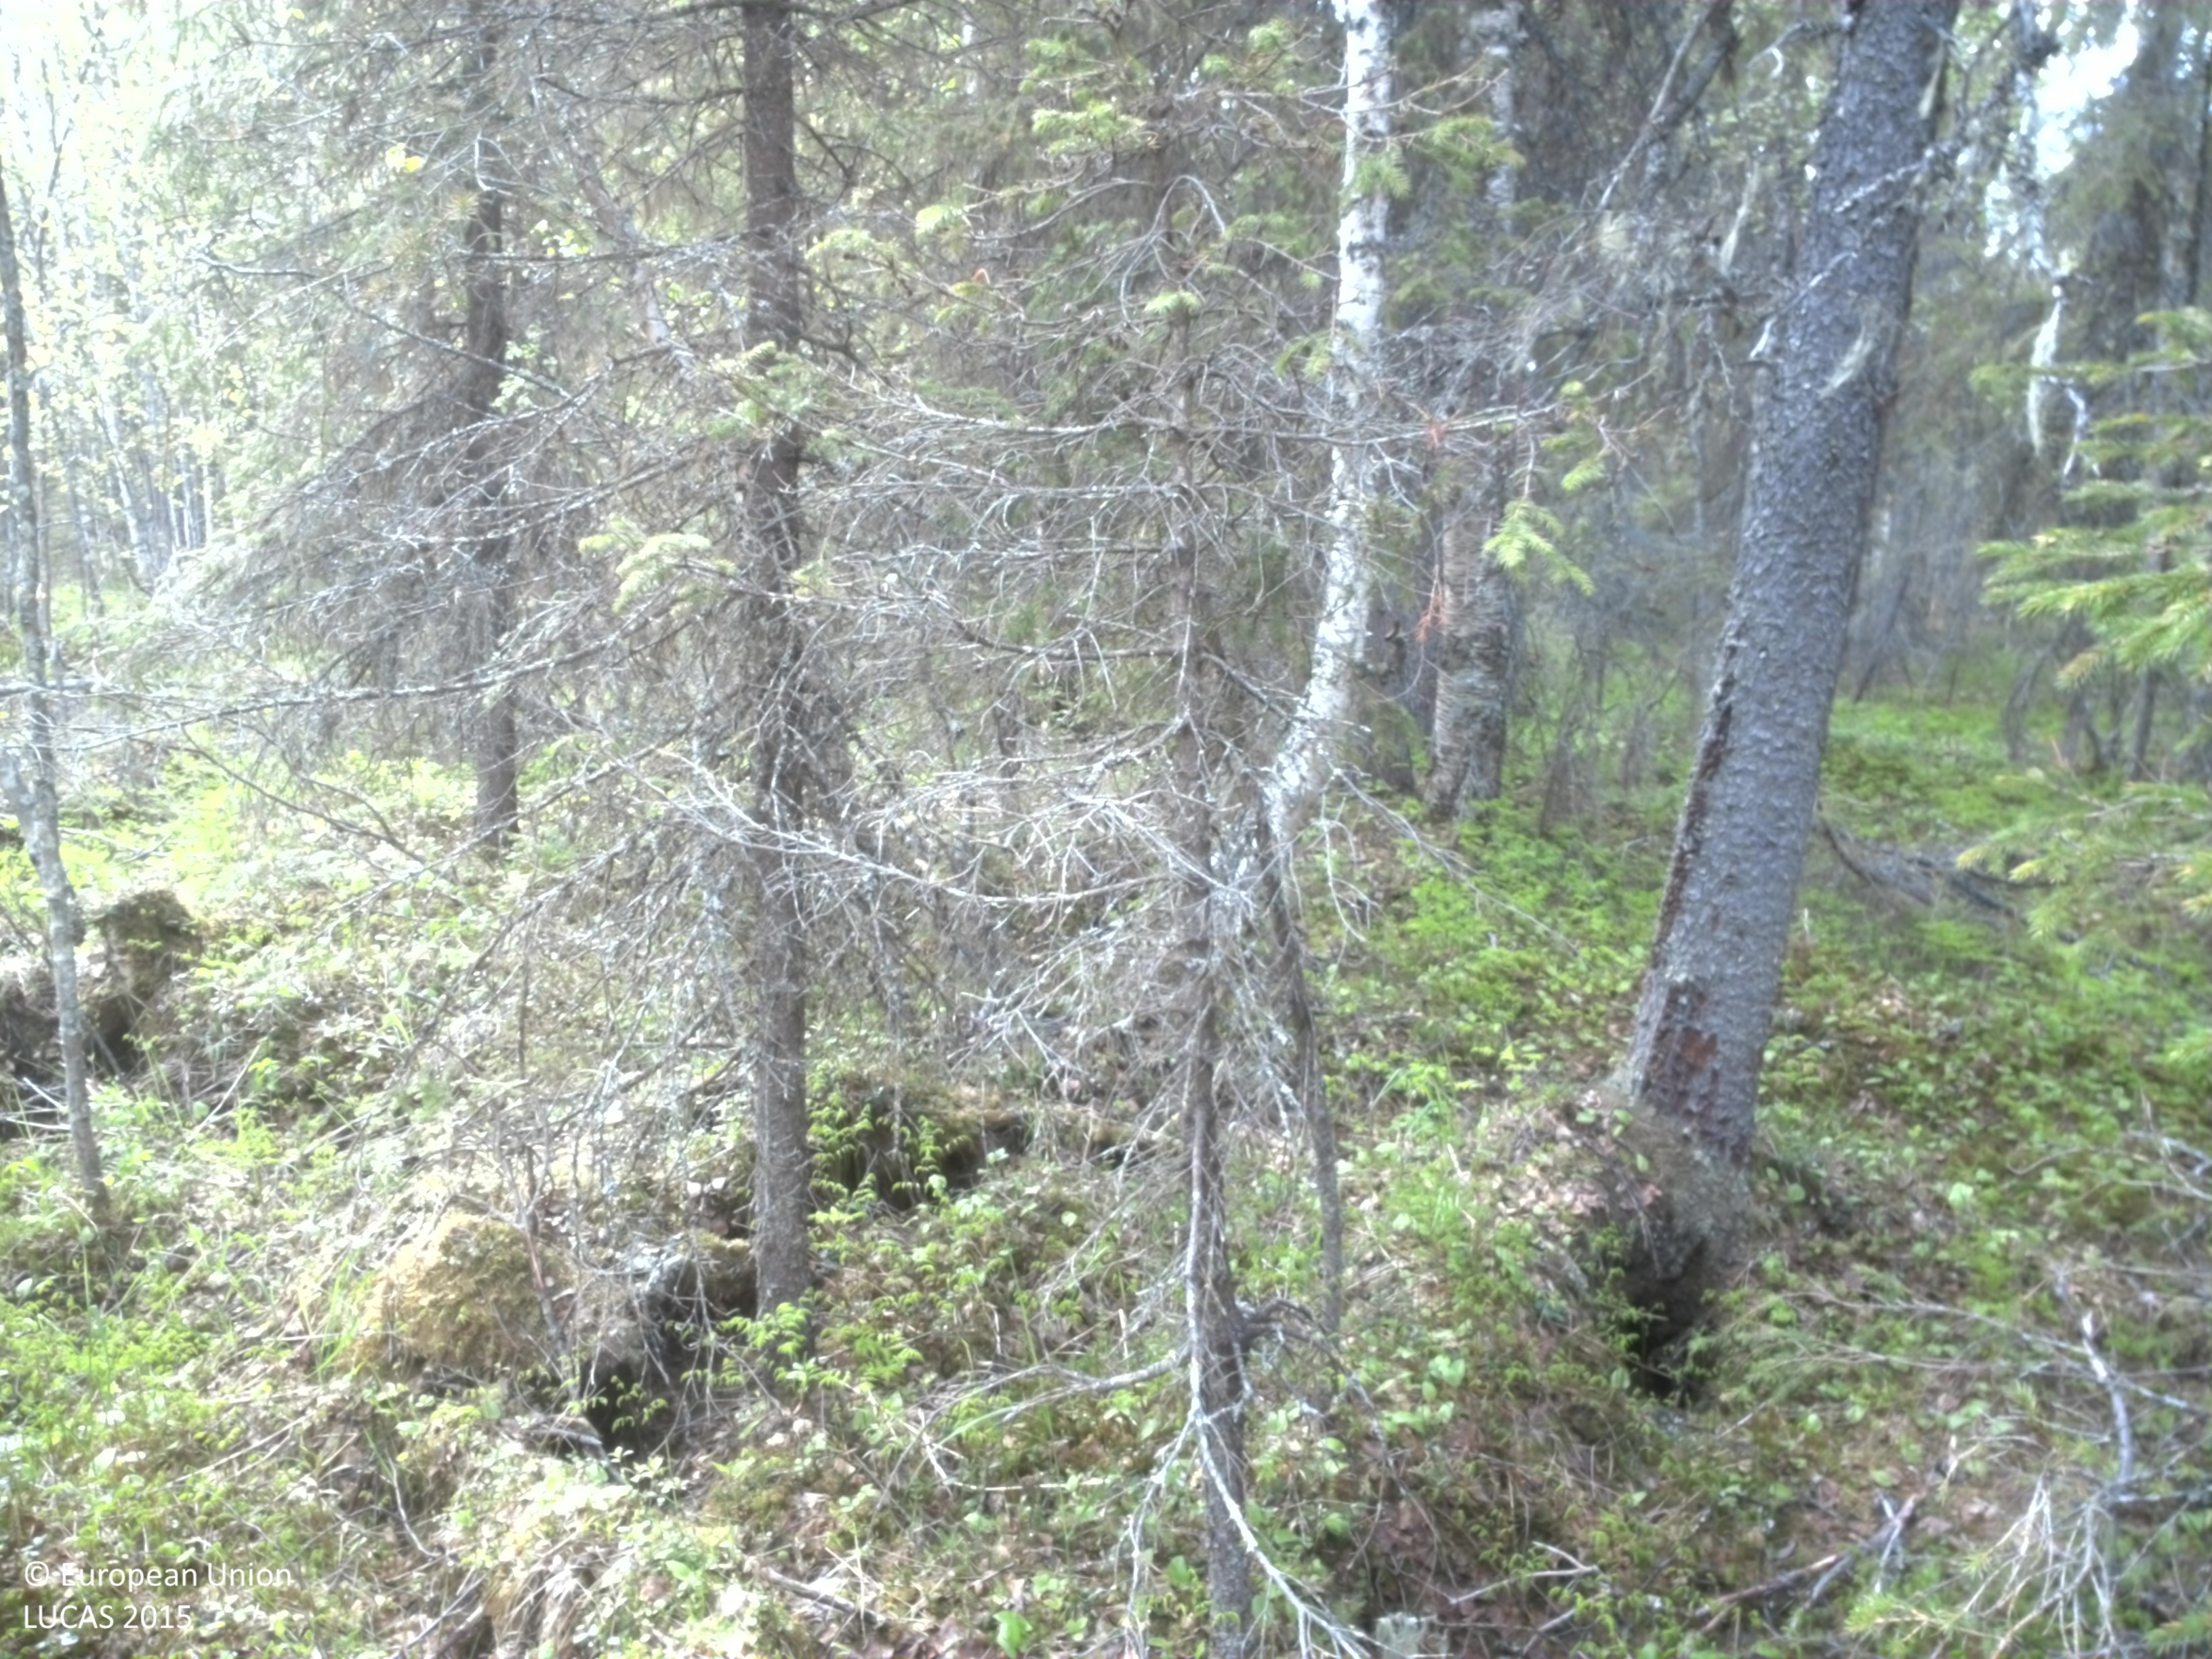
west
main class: Woodland
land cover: Spruce dominated mixed woodland
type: boreal forest
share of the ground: 50 - 75 %
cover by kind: coniferous forest trees 35 %, herbaceous plants 35 %, broadleaved forest trees 20 %, shrubs 5 %, lichens and mosses 5 %
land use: Forestry
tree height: > 5 m
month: June
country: SE
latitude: 67.0002
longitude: 22.0472
